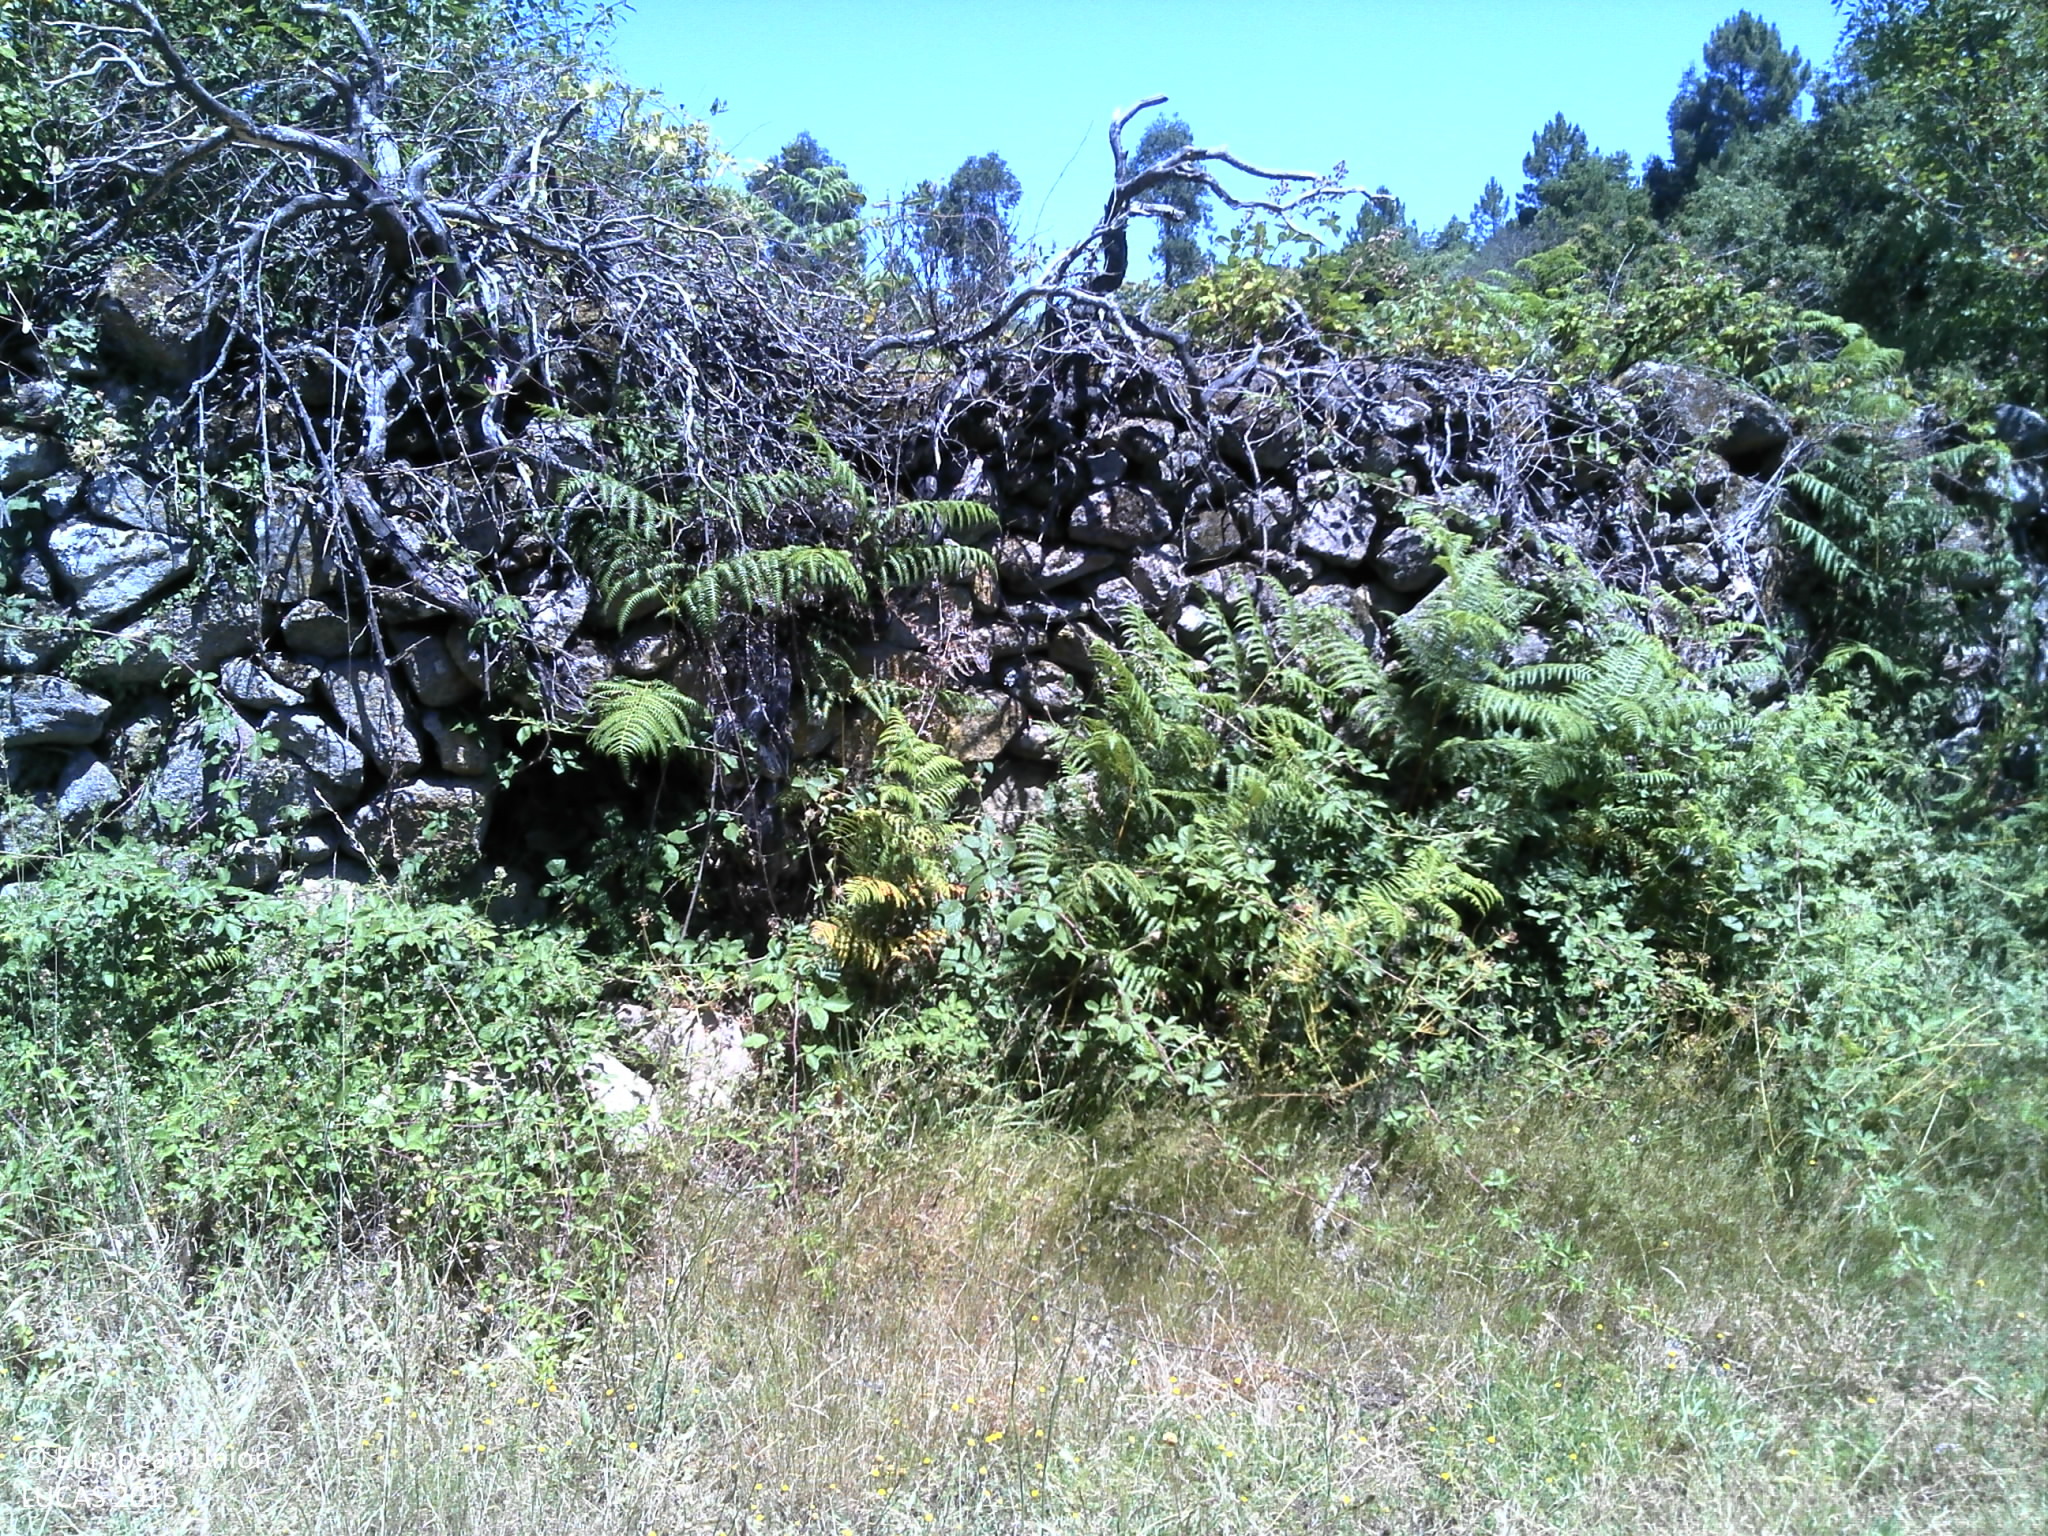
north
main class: Grassland
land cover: Grassland without tree/shrub cover
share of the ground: > 75 %
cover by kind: herbaceous plants 100 %
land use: Agriculture (excluding fallow land and kitchen gardens)
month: June
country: PT
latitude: 40.7515
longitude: -7.2716
